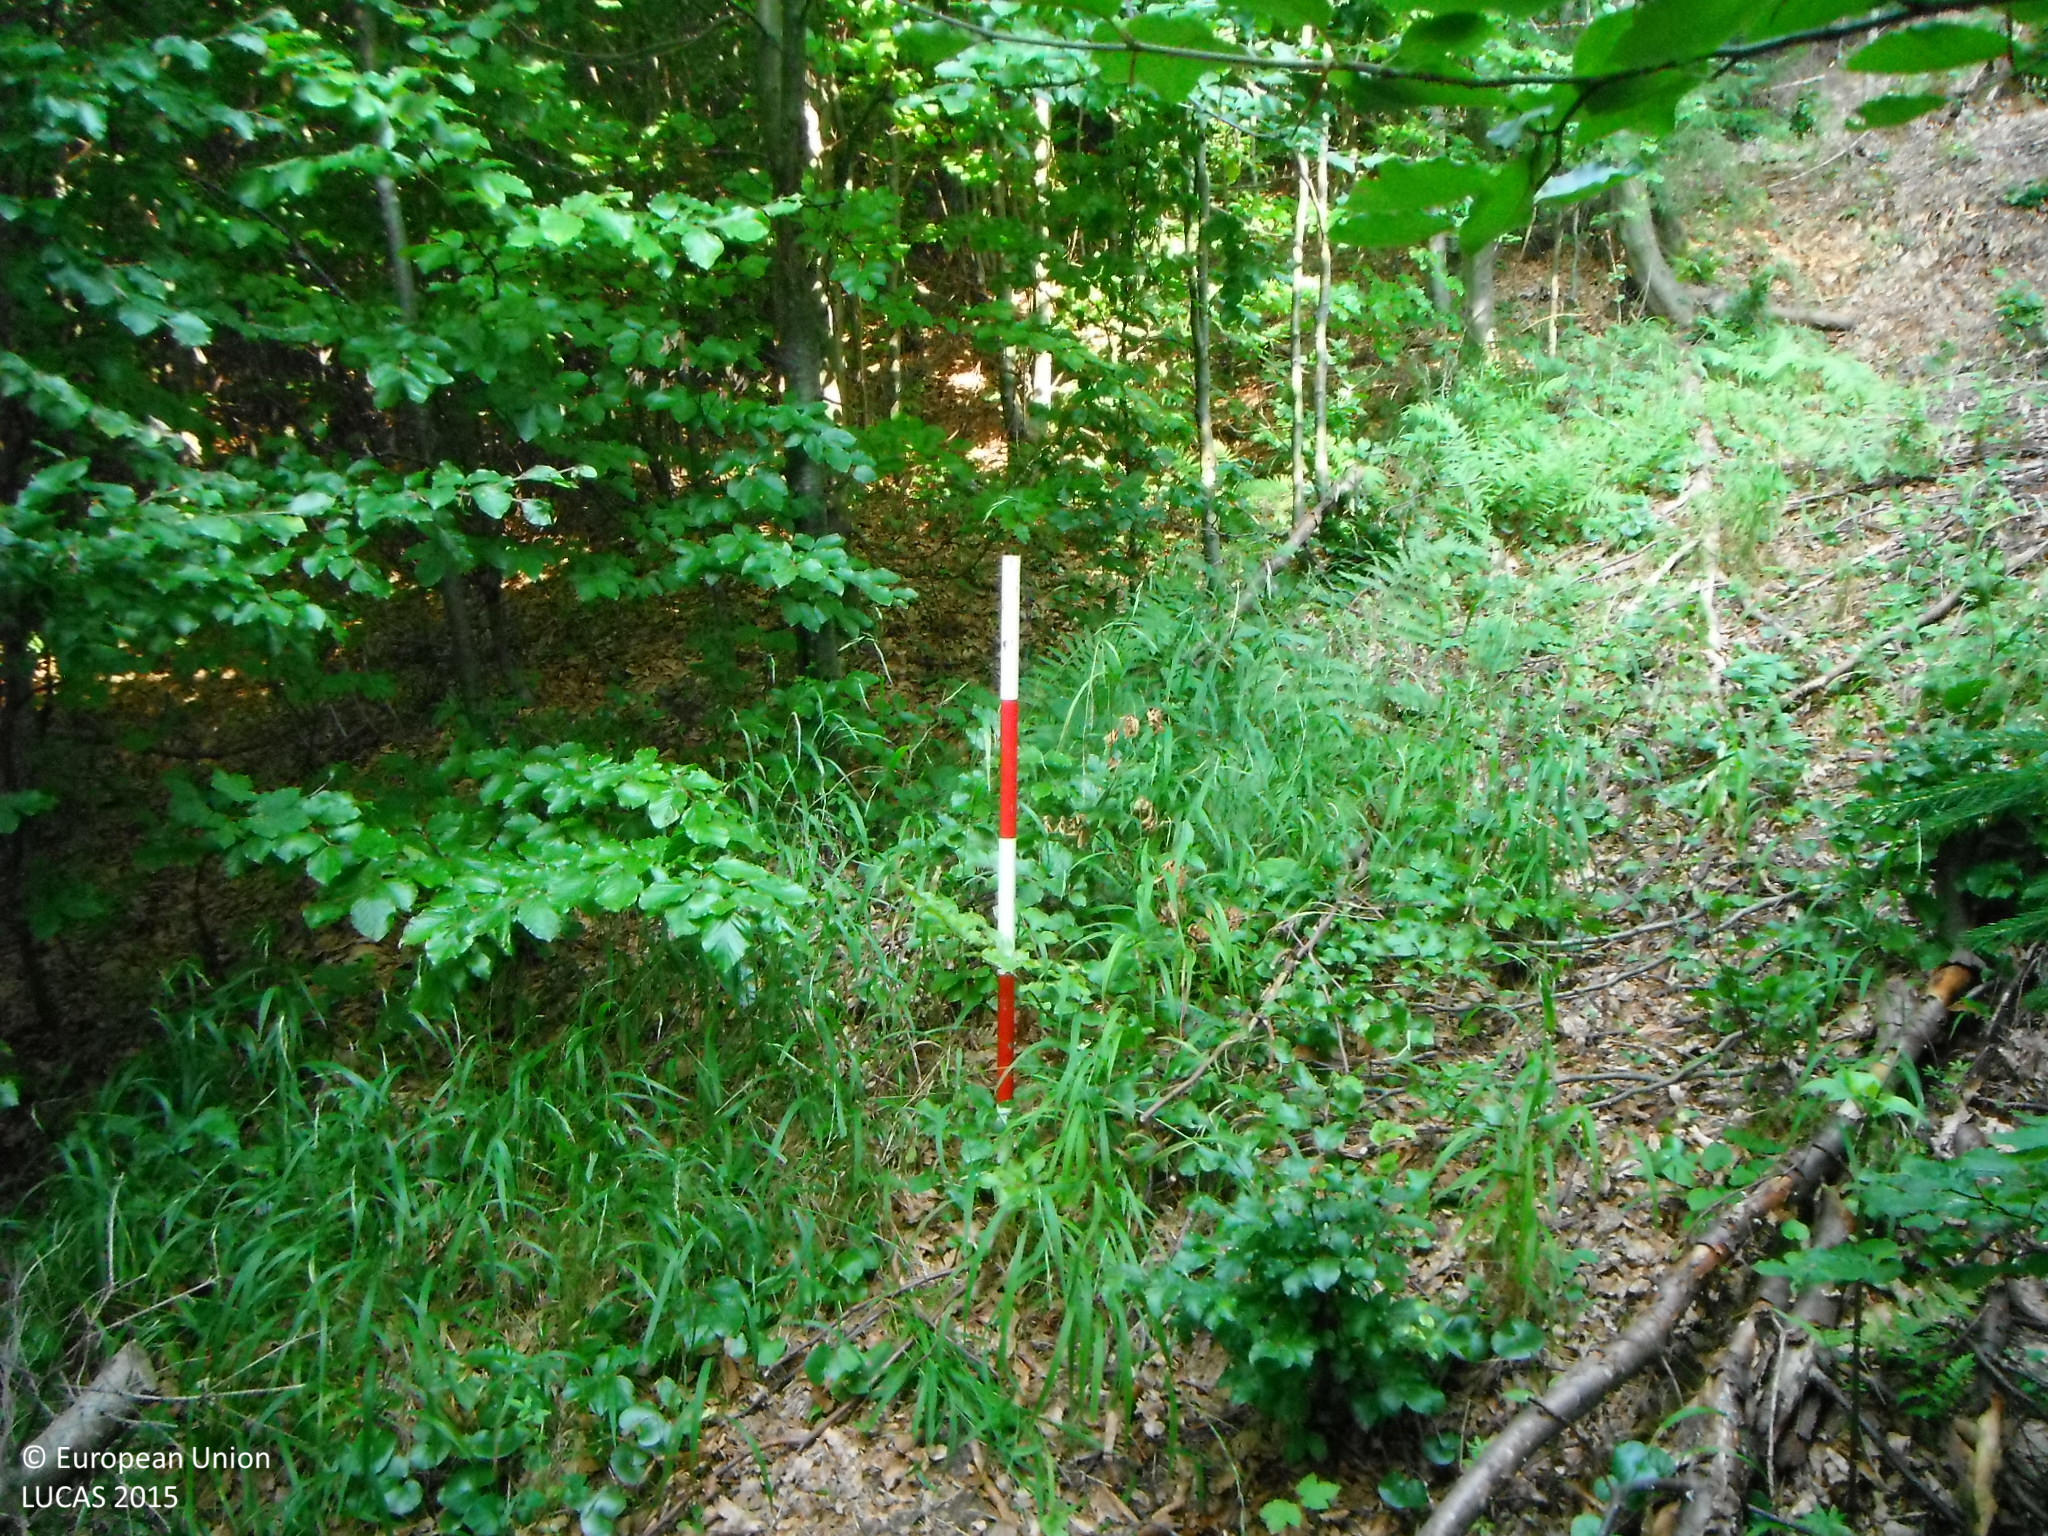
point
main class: Woodland
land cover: Broadleaved woodland
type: mountainous beech forest
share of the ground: > 75 %
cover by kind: broadleaved forest trees 100 %
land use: Forestry
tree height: > 5 m
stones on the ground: < 10 %
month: August
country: SK
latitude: 48.8481
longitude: 19.0293
